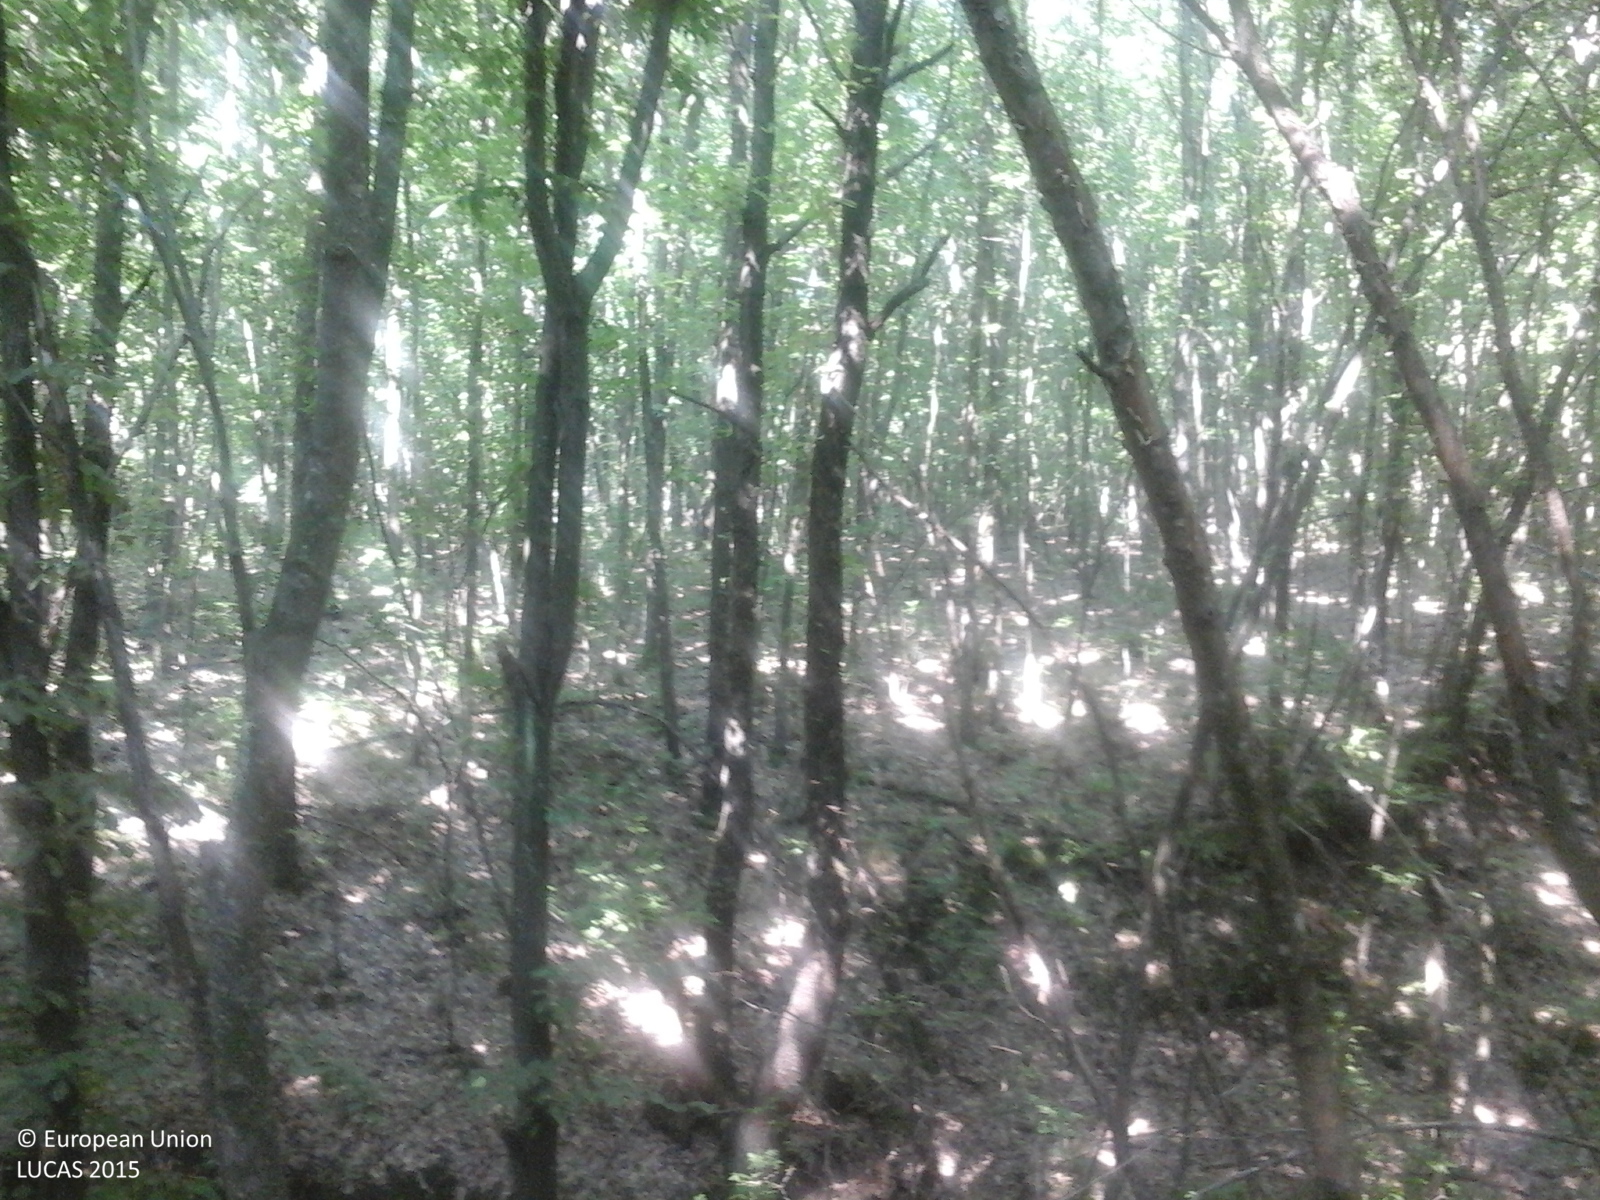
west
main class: Woodland
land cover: Broadleaved woodland
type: beech forest
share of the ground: > 75 %
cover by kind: broadleaved forest trees 100 %
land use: Forestry
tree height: > 5 m
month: July
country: RO
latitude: 44.7689
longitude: 24.3869
